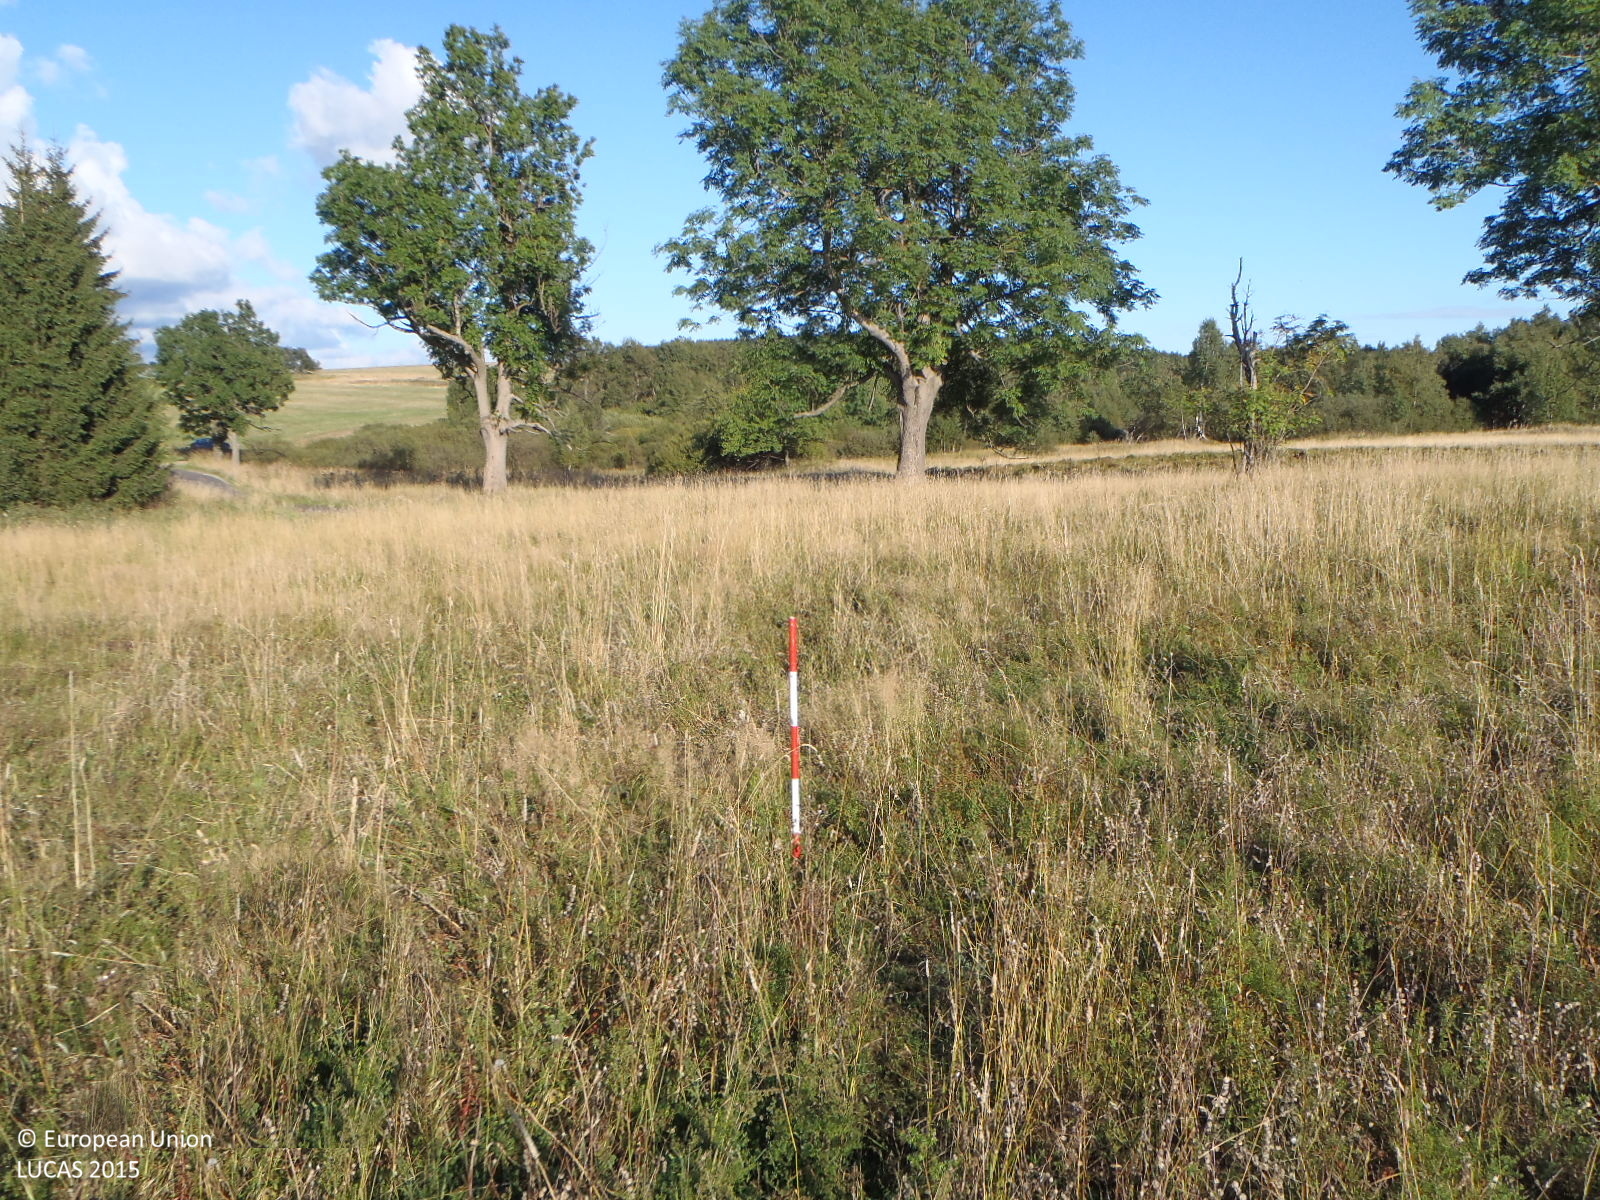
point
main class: Grassland
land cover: Grassland without tree/shrub cover
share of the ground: > 75 %
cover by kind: herbaceous plants 100 %
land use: Agriculture (excluding fallow land and kitchen gardens)
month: September
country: CZ
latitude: 50.7297
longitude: 13.8969
